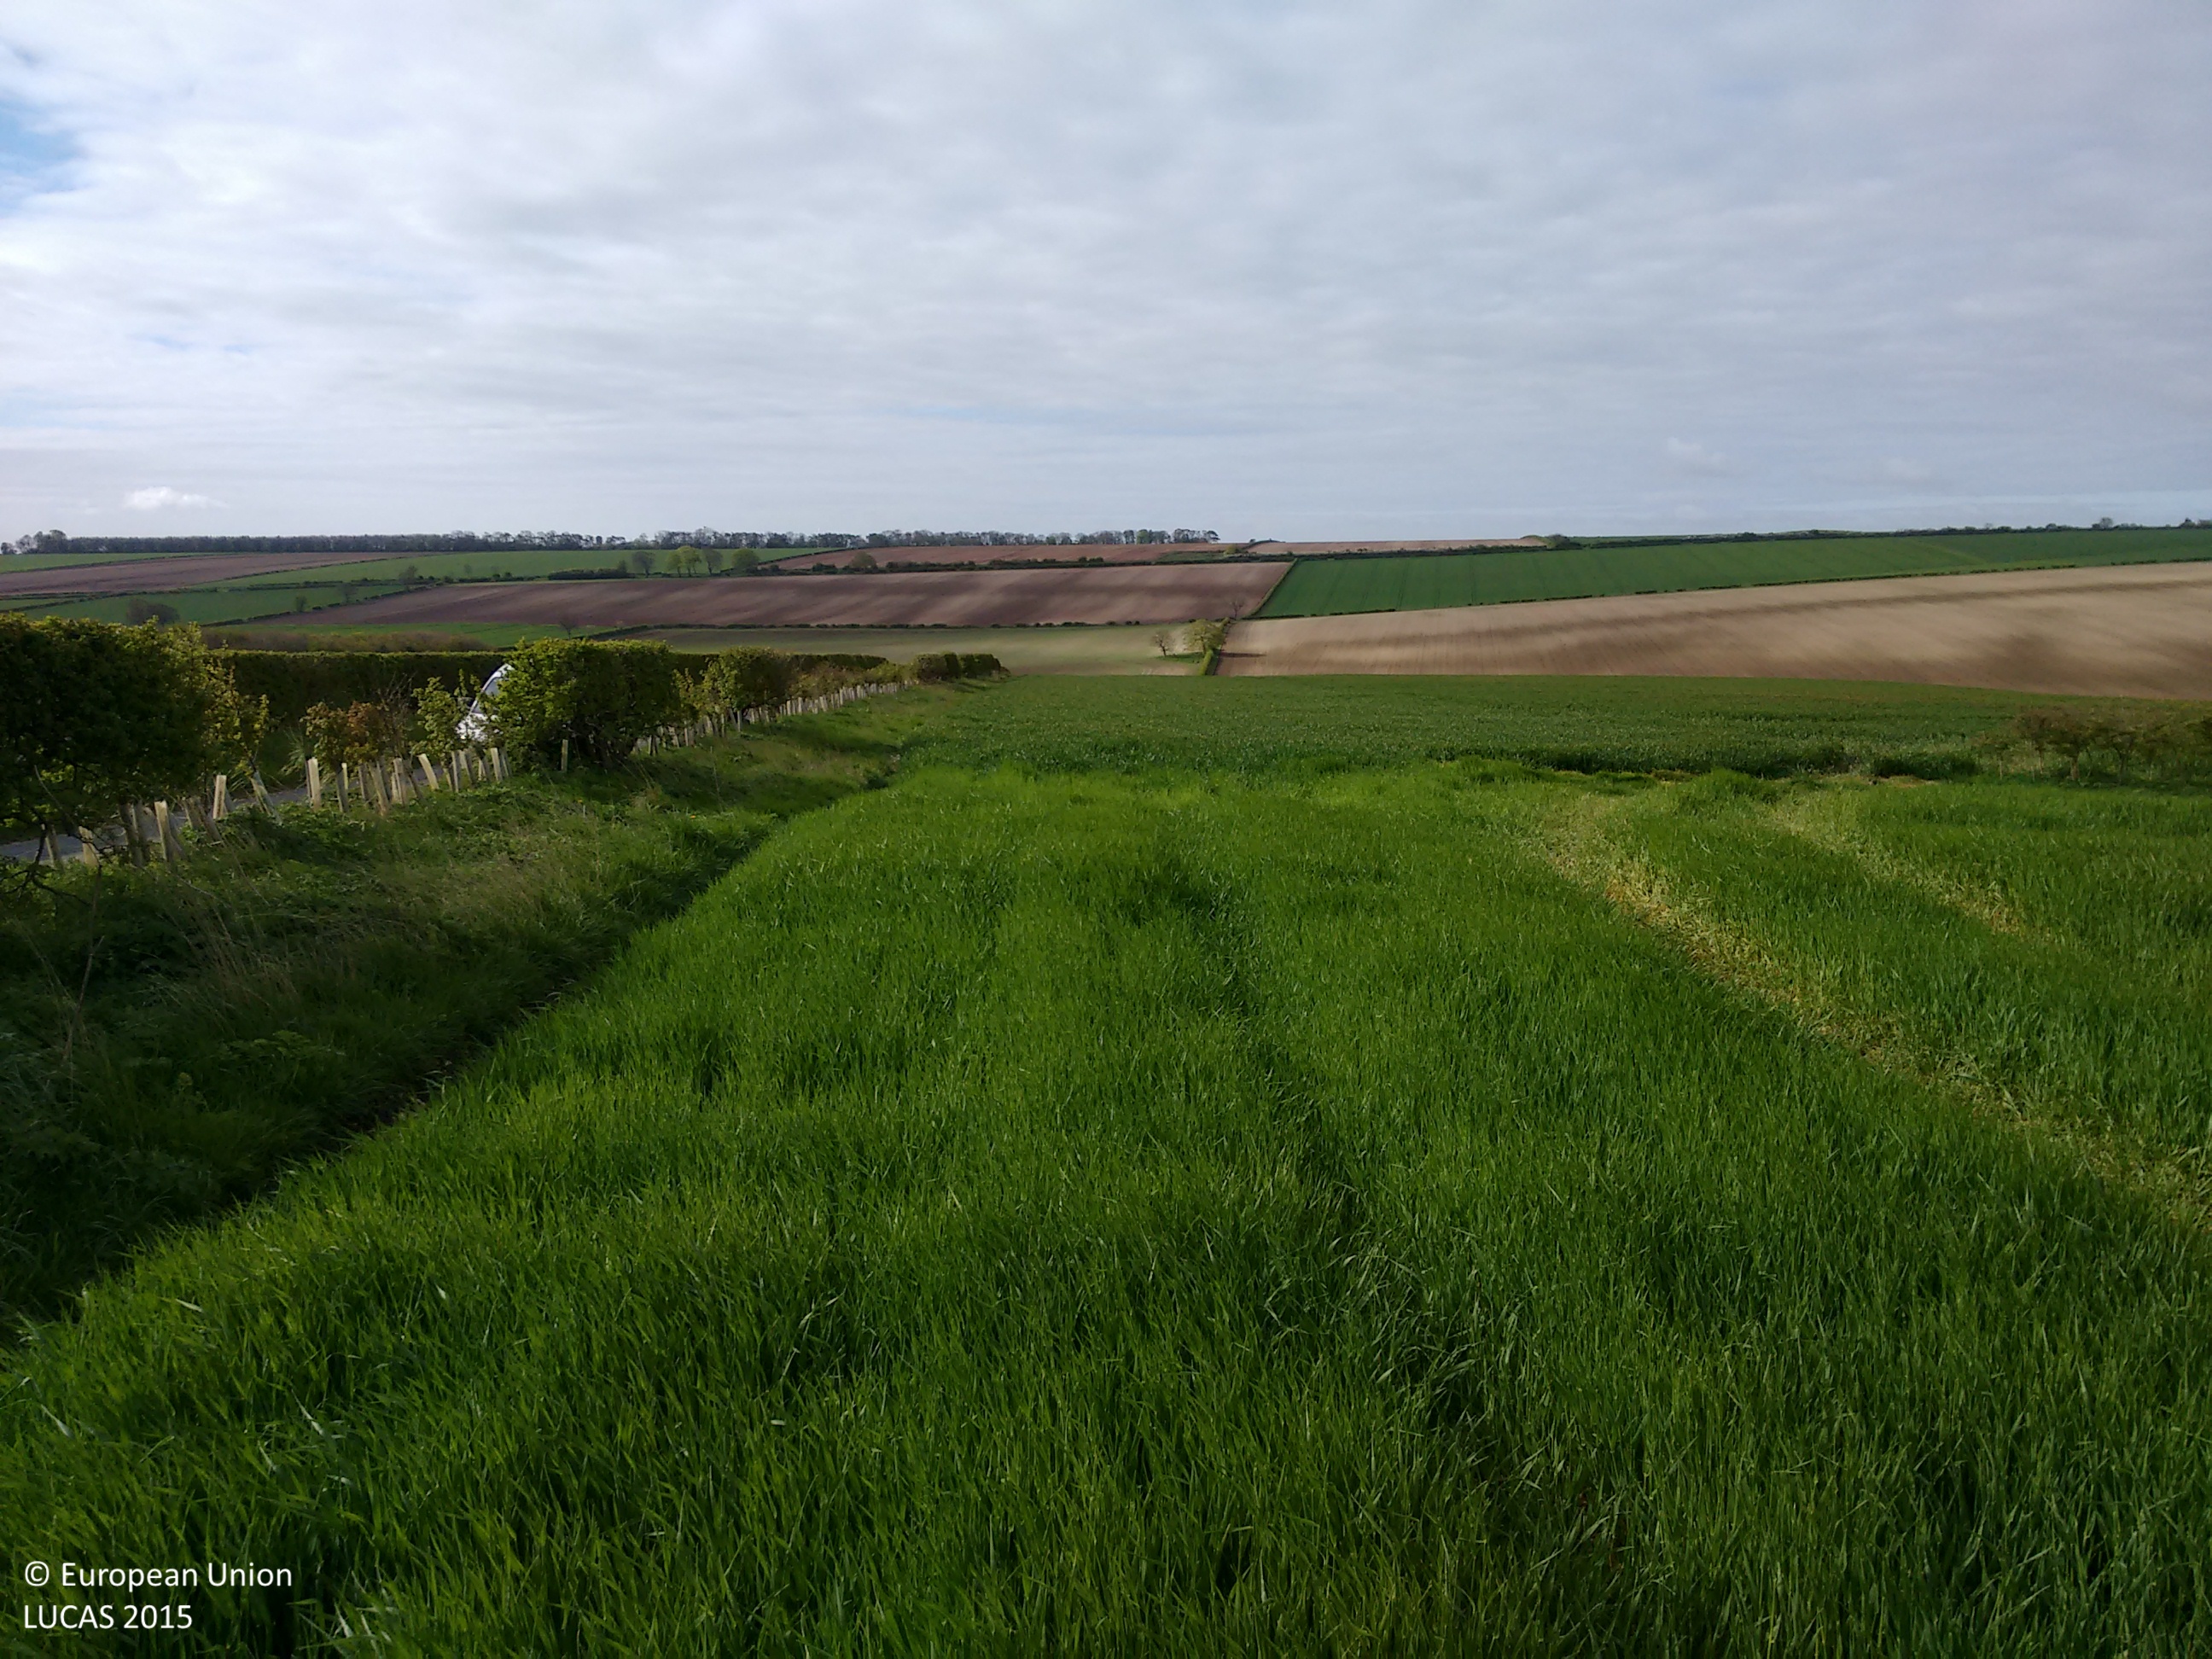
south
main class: Cropland
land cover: Barley
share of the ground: > 75 %
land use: Agriculture (excluding fallow land and kitchen gardens)
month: May
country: GB
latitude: 54.0761
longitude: -0.4129
